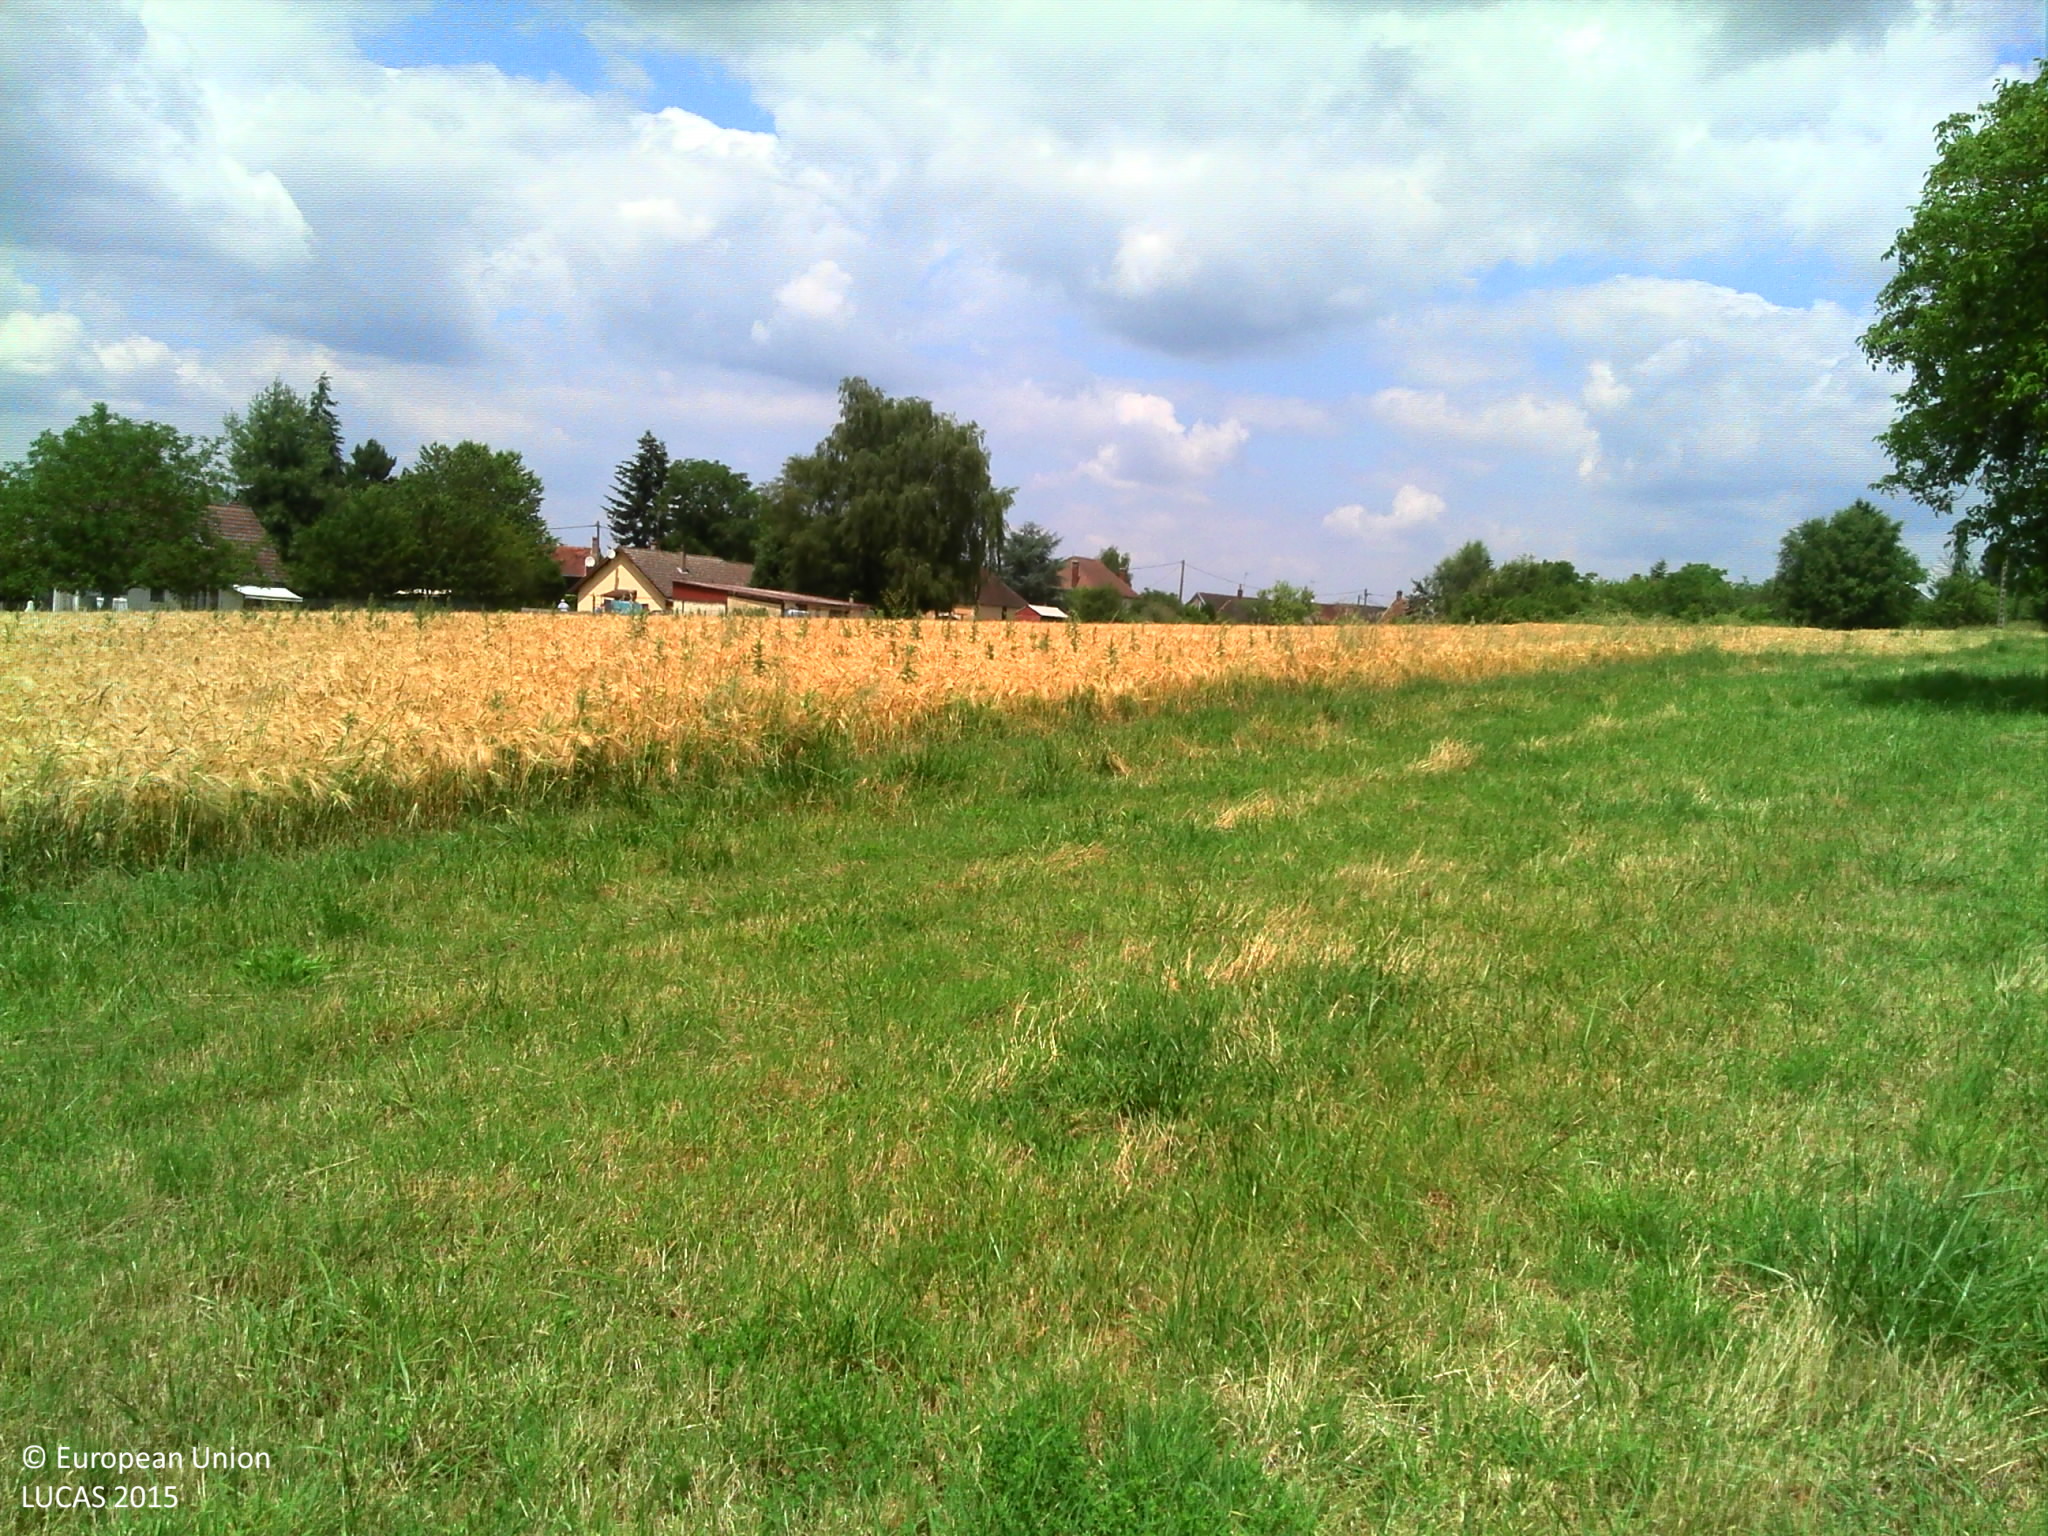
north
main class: Grassland
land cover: Grassland without tree/shrub cover
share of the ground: > 75 %
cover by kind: herbaceous plants 100 %
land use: Agriculture (excluding fallow land and kitchen gardens)
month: June
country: FR
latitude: 47.5035
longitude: 3.1311
